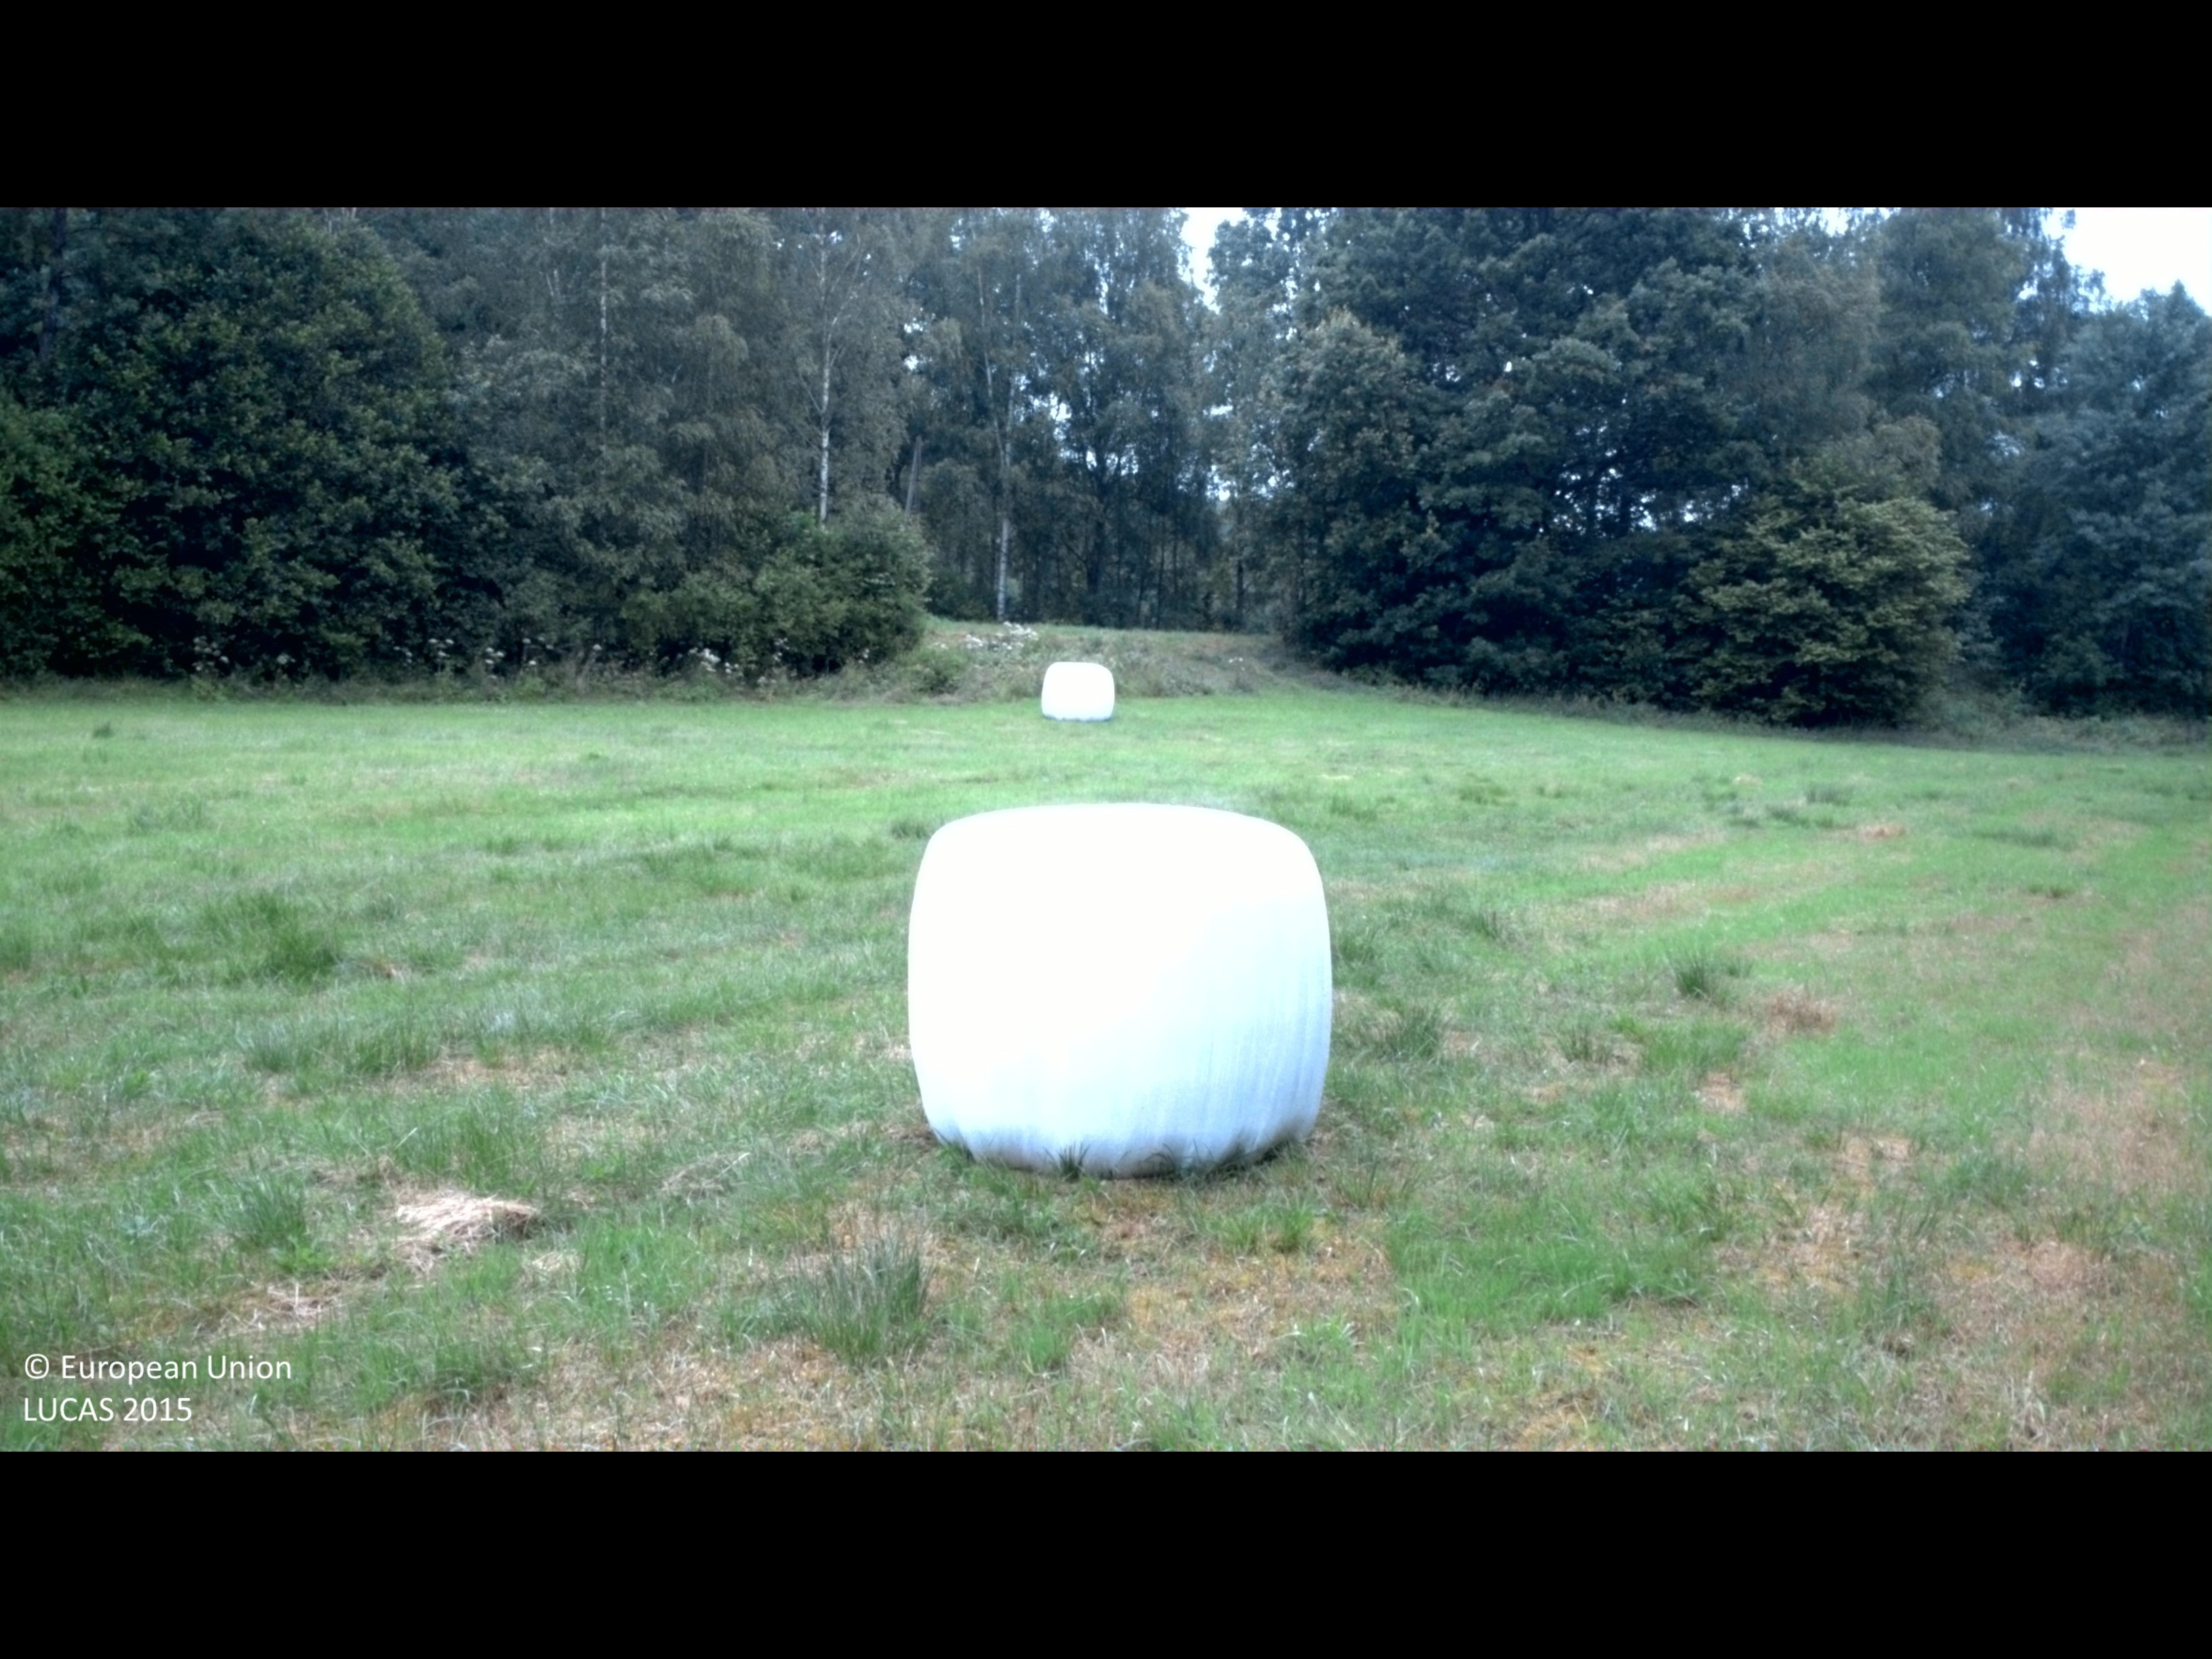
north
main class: Grassland
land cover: Grassland without tree/shrub cover
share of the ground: 50 - 75 %
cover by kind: herbaceous plants 60 %, lichens and mosses 40 %
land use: Agriculture (excluding fallow land and kitchen gardens)
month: July
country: SE
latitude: 56.4843
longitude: 14.0406
